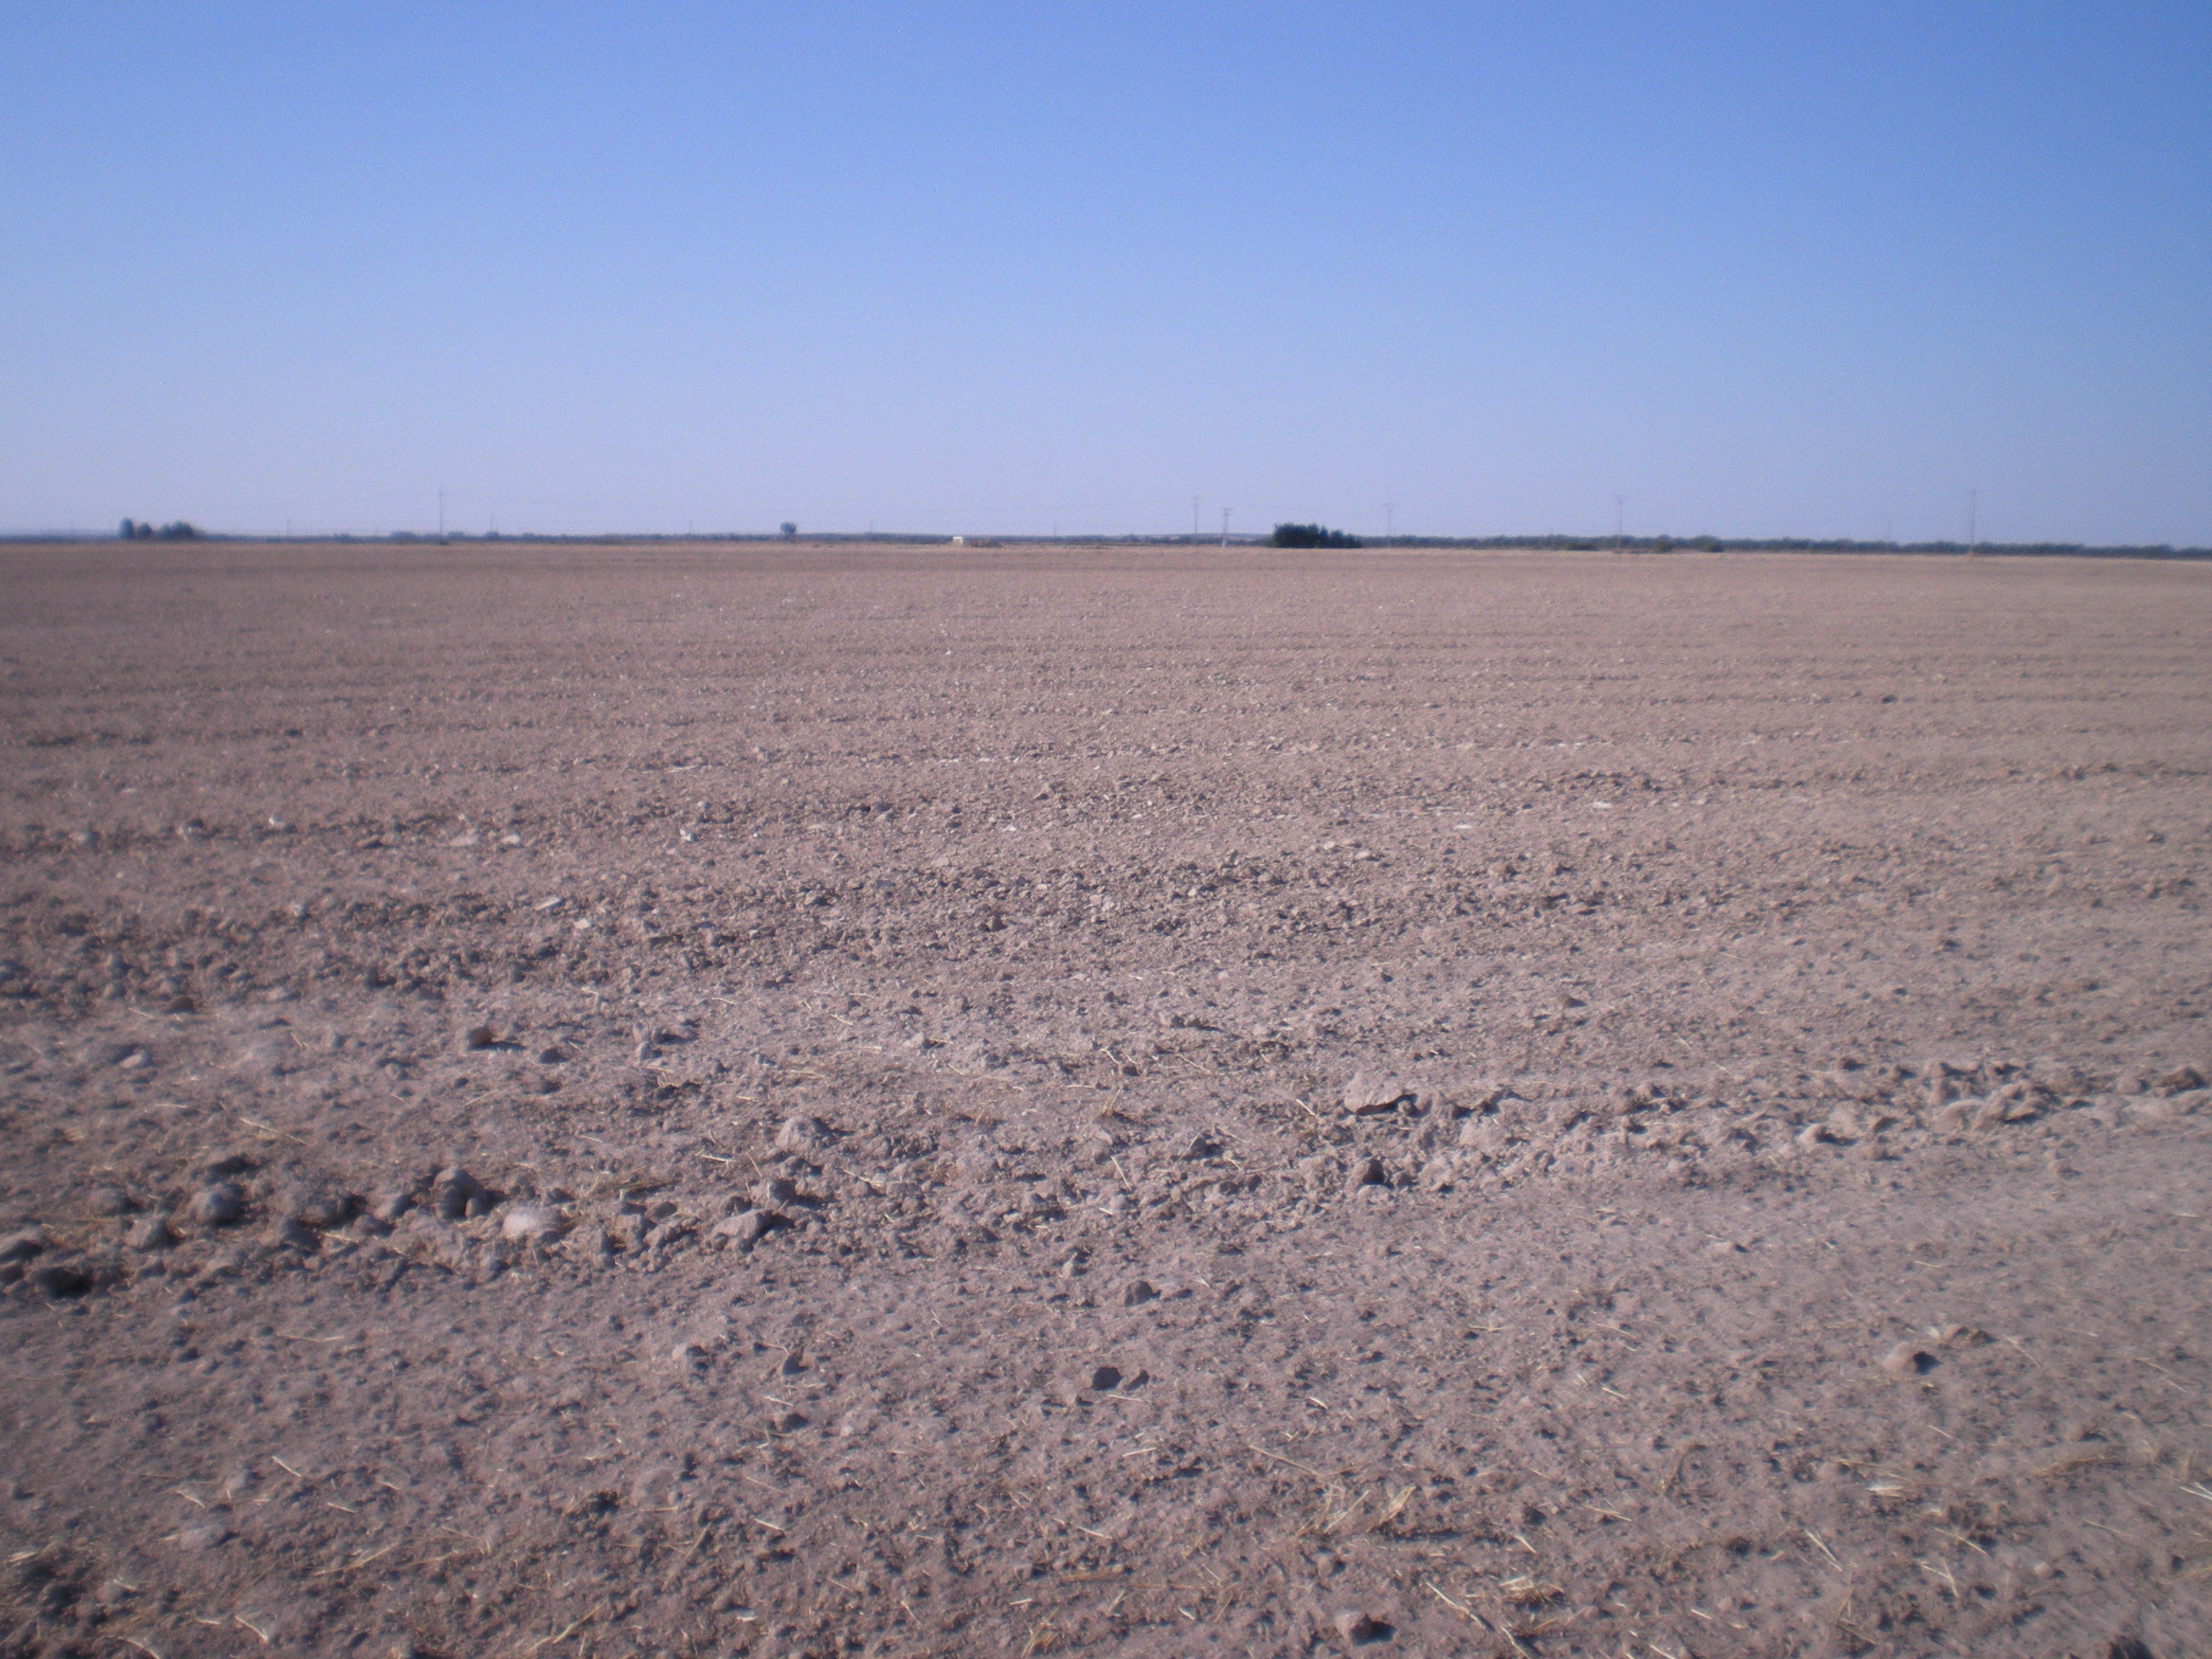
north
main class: Cropland
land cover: Durum wheat
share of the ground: < 10 %
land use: Agriculture (excluding fallow land and kitchen gardens)
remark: Harvested field
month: July
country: ES
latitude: 39.3743
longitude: -3.3100
